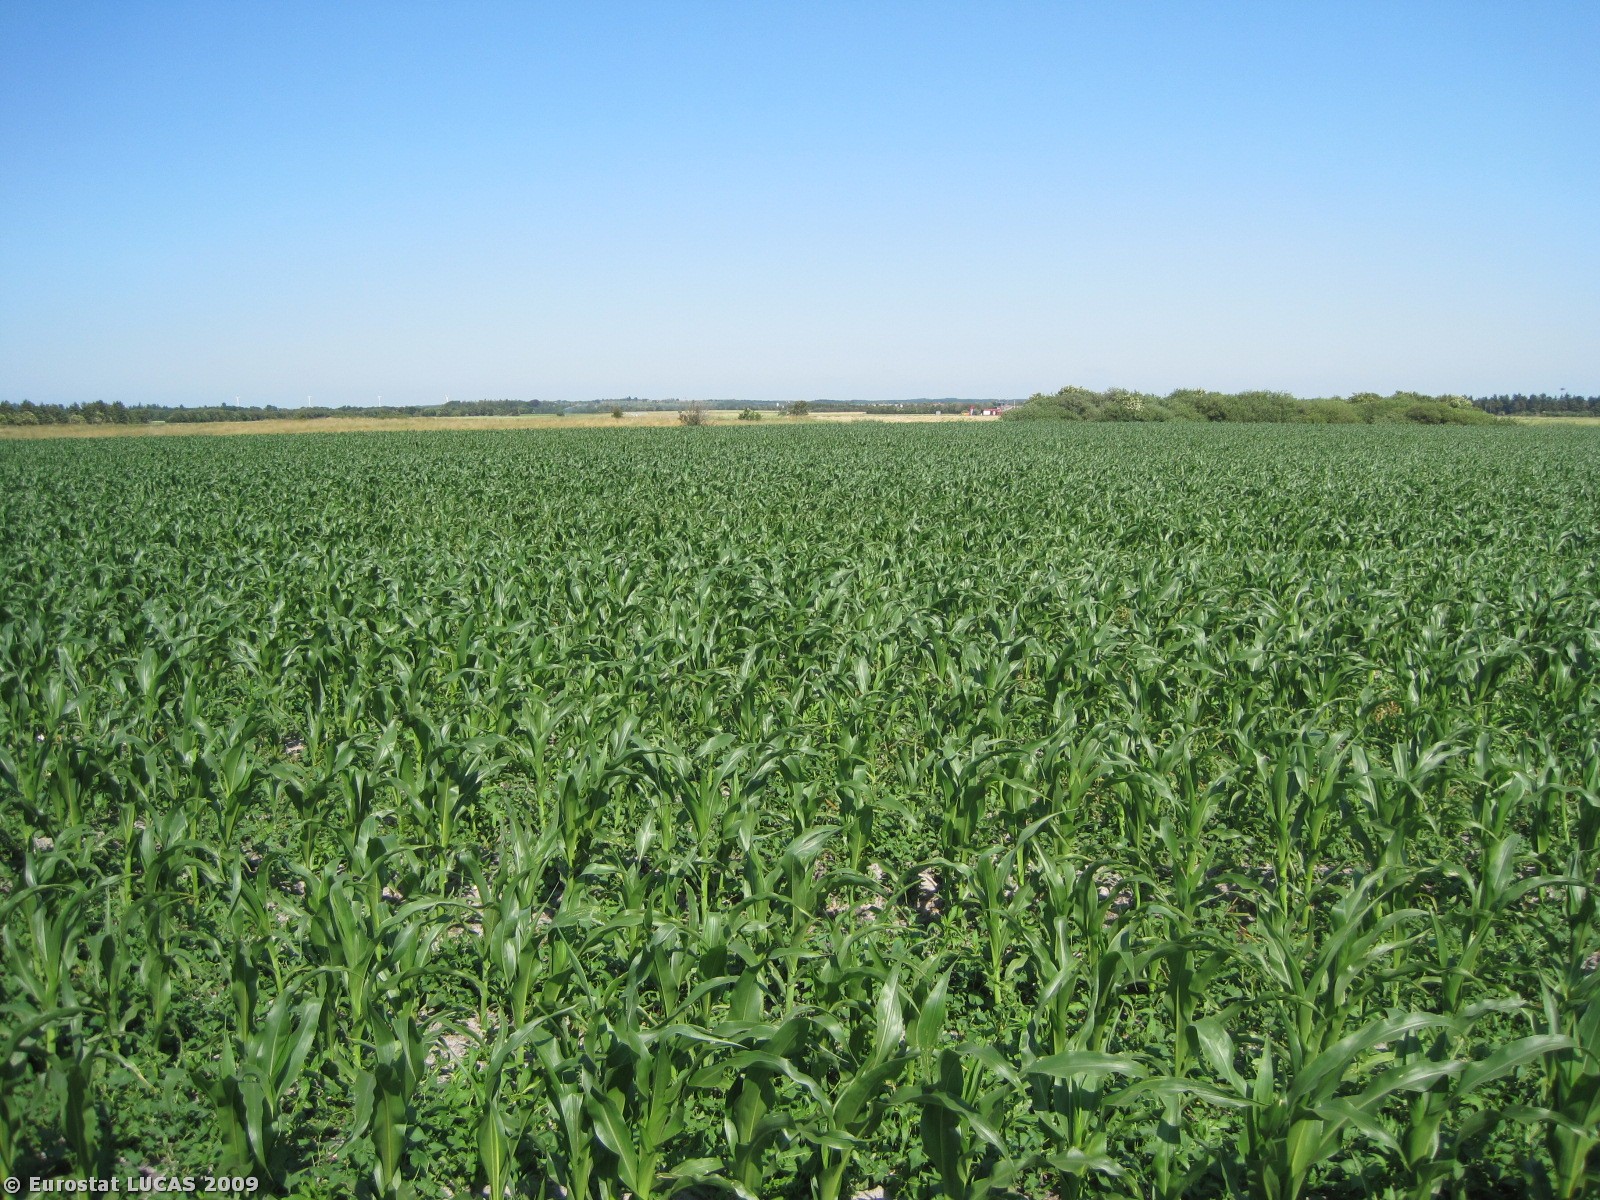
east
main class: Cropland
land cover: Maize
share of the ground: 25 - 50 %
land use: Agriculture (excluding fallow land and kitchen gardens)
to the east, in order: Maize; Grassland with sparse tree/shrub cover; Grassland without tree/shrub cover; Rivers and streams; Grassland without tree/shrub cover; Shrubland without tree cover; Broadleaved woodland; Grassland without tree/shrub cover
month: July
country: DK
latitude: 56.3939
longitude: 8.4305
